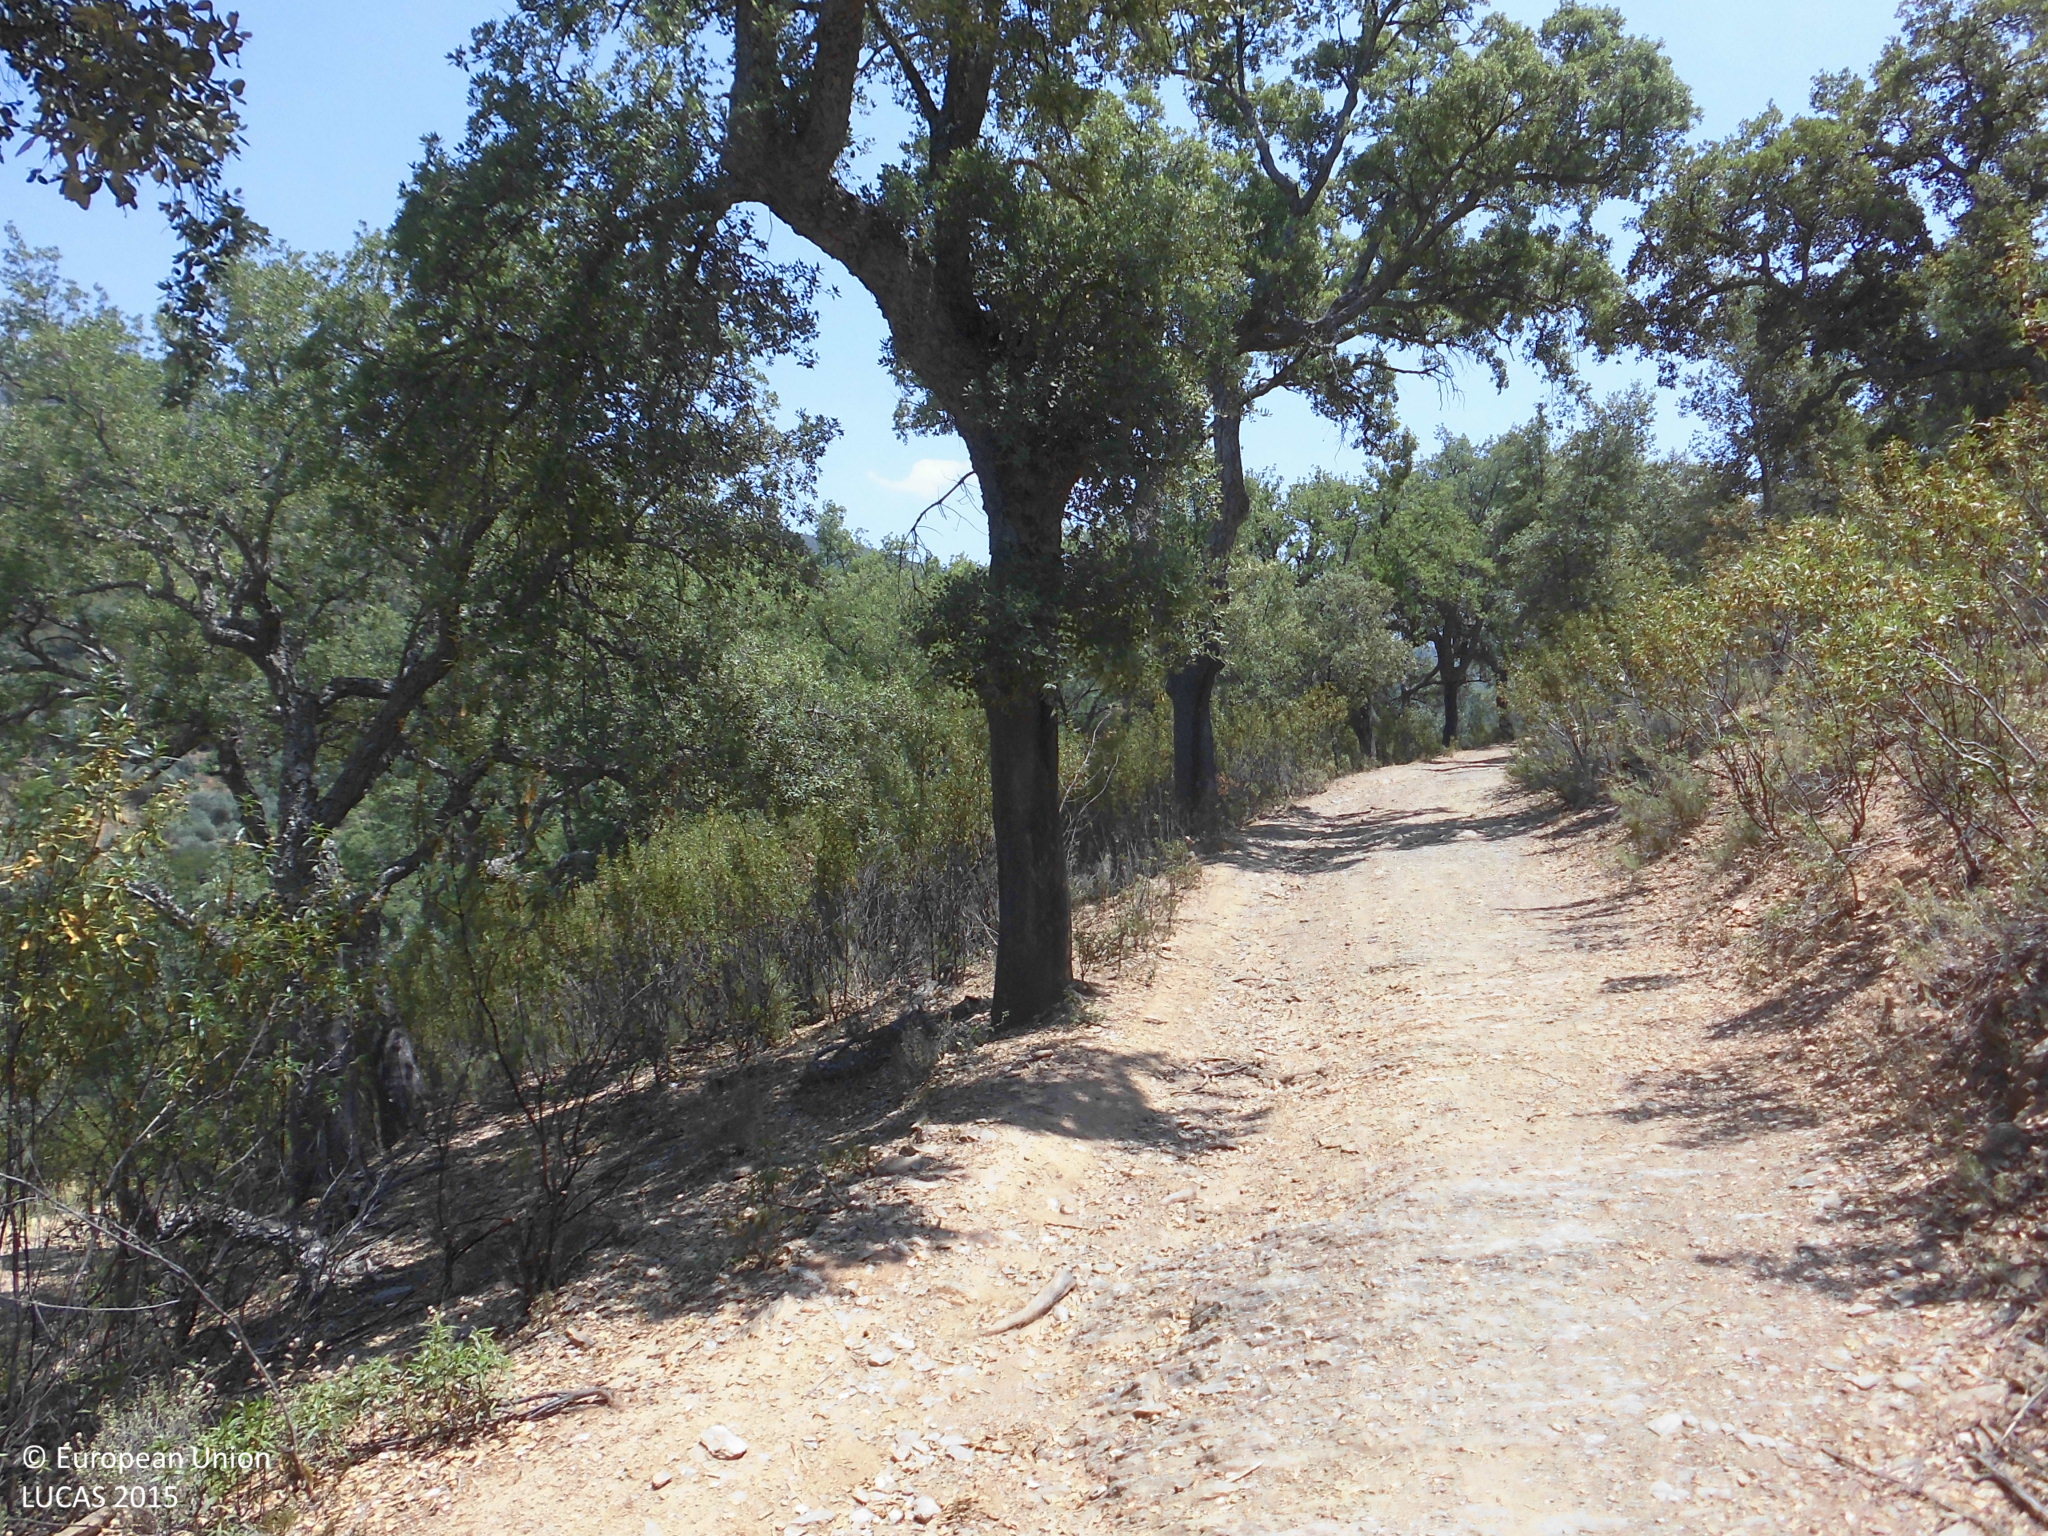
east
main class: Woodland
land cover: Broadleaved woodland
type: broadleaved evergreen forest
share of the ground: 10 - 25 %
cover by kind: herbaceous plants 60 %, shrubs 25 %, broadleaved forest trees 15 %
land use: Forestry
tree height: > 5 m
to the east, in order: Broadleaved woodland
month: June
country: ES
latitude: 39.5612
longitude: -5.3796
